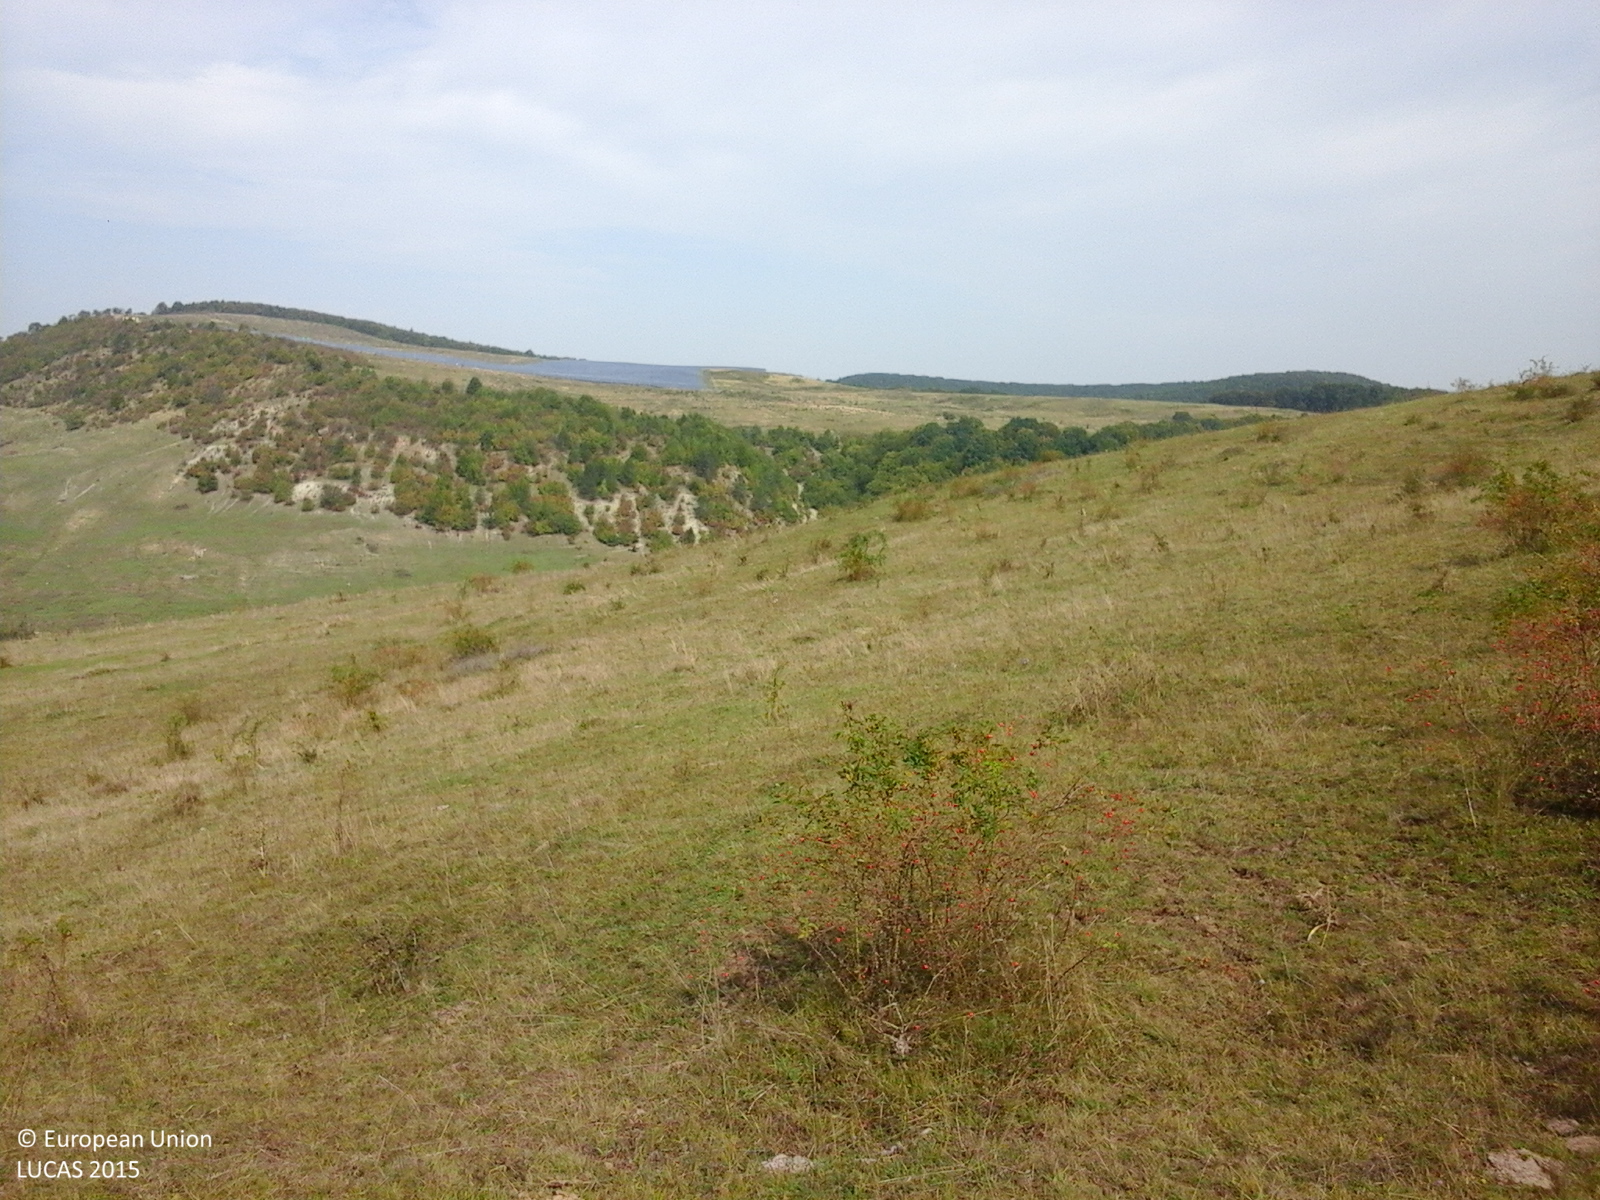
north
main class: Grassland
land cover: Grassland with sparse tree/shrub cover
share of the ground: > 75 %
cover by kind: herbaceous plants 85 %, shrubs 10 %, broadleaved forest trees 5 %
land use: Agriculture (excluding fallow land and kitchen gardens)
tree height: < 5 m
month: September
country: RO
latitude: 47.1312
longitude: 23.8011
